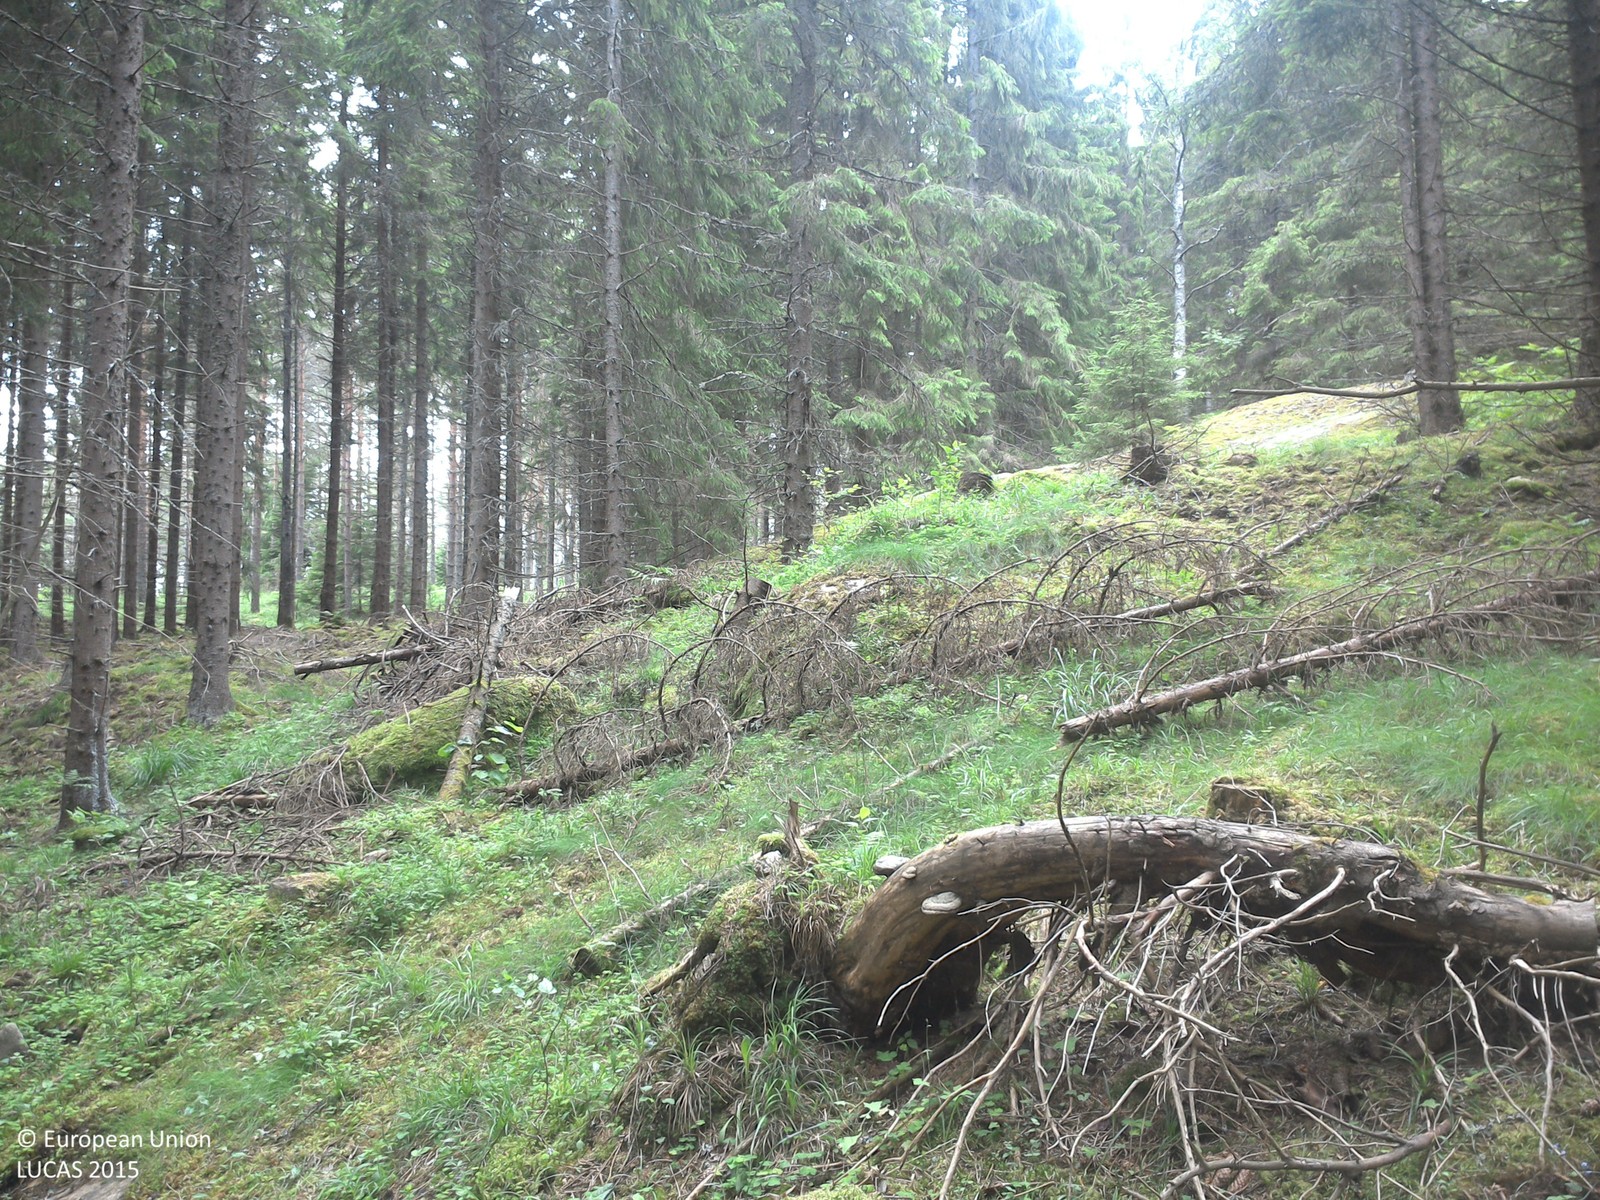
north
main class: Woodland
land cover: Spruce dominated coniferous woodland
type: boreal forest
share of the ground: 50 - 75 %
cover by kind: coniferous forest trees 60 %, lichens and mosses 40 %
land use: Forestry
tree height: > 5 m
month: June
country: SE
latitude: 58.0914
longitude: 15.4402
